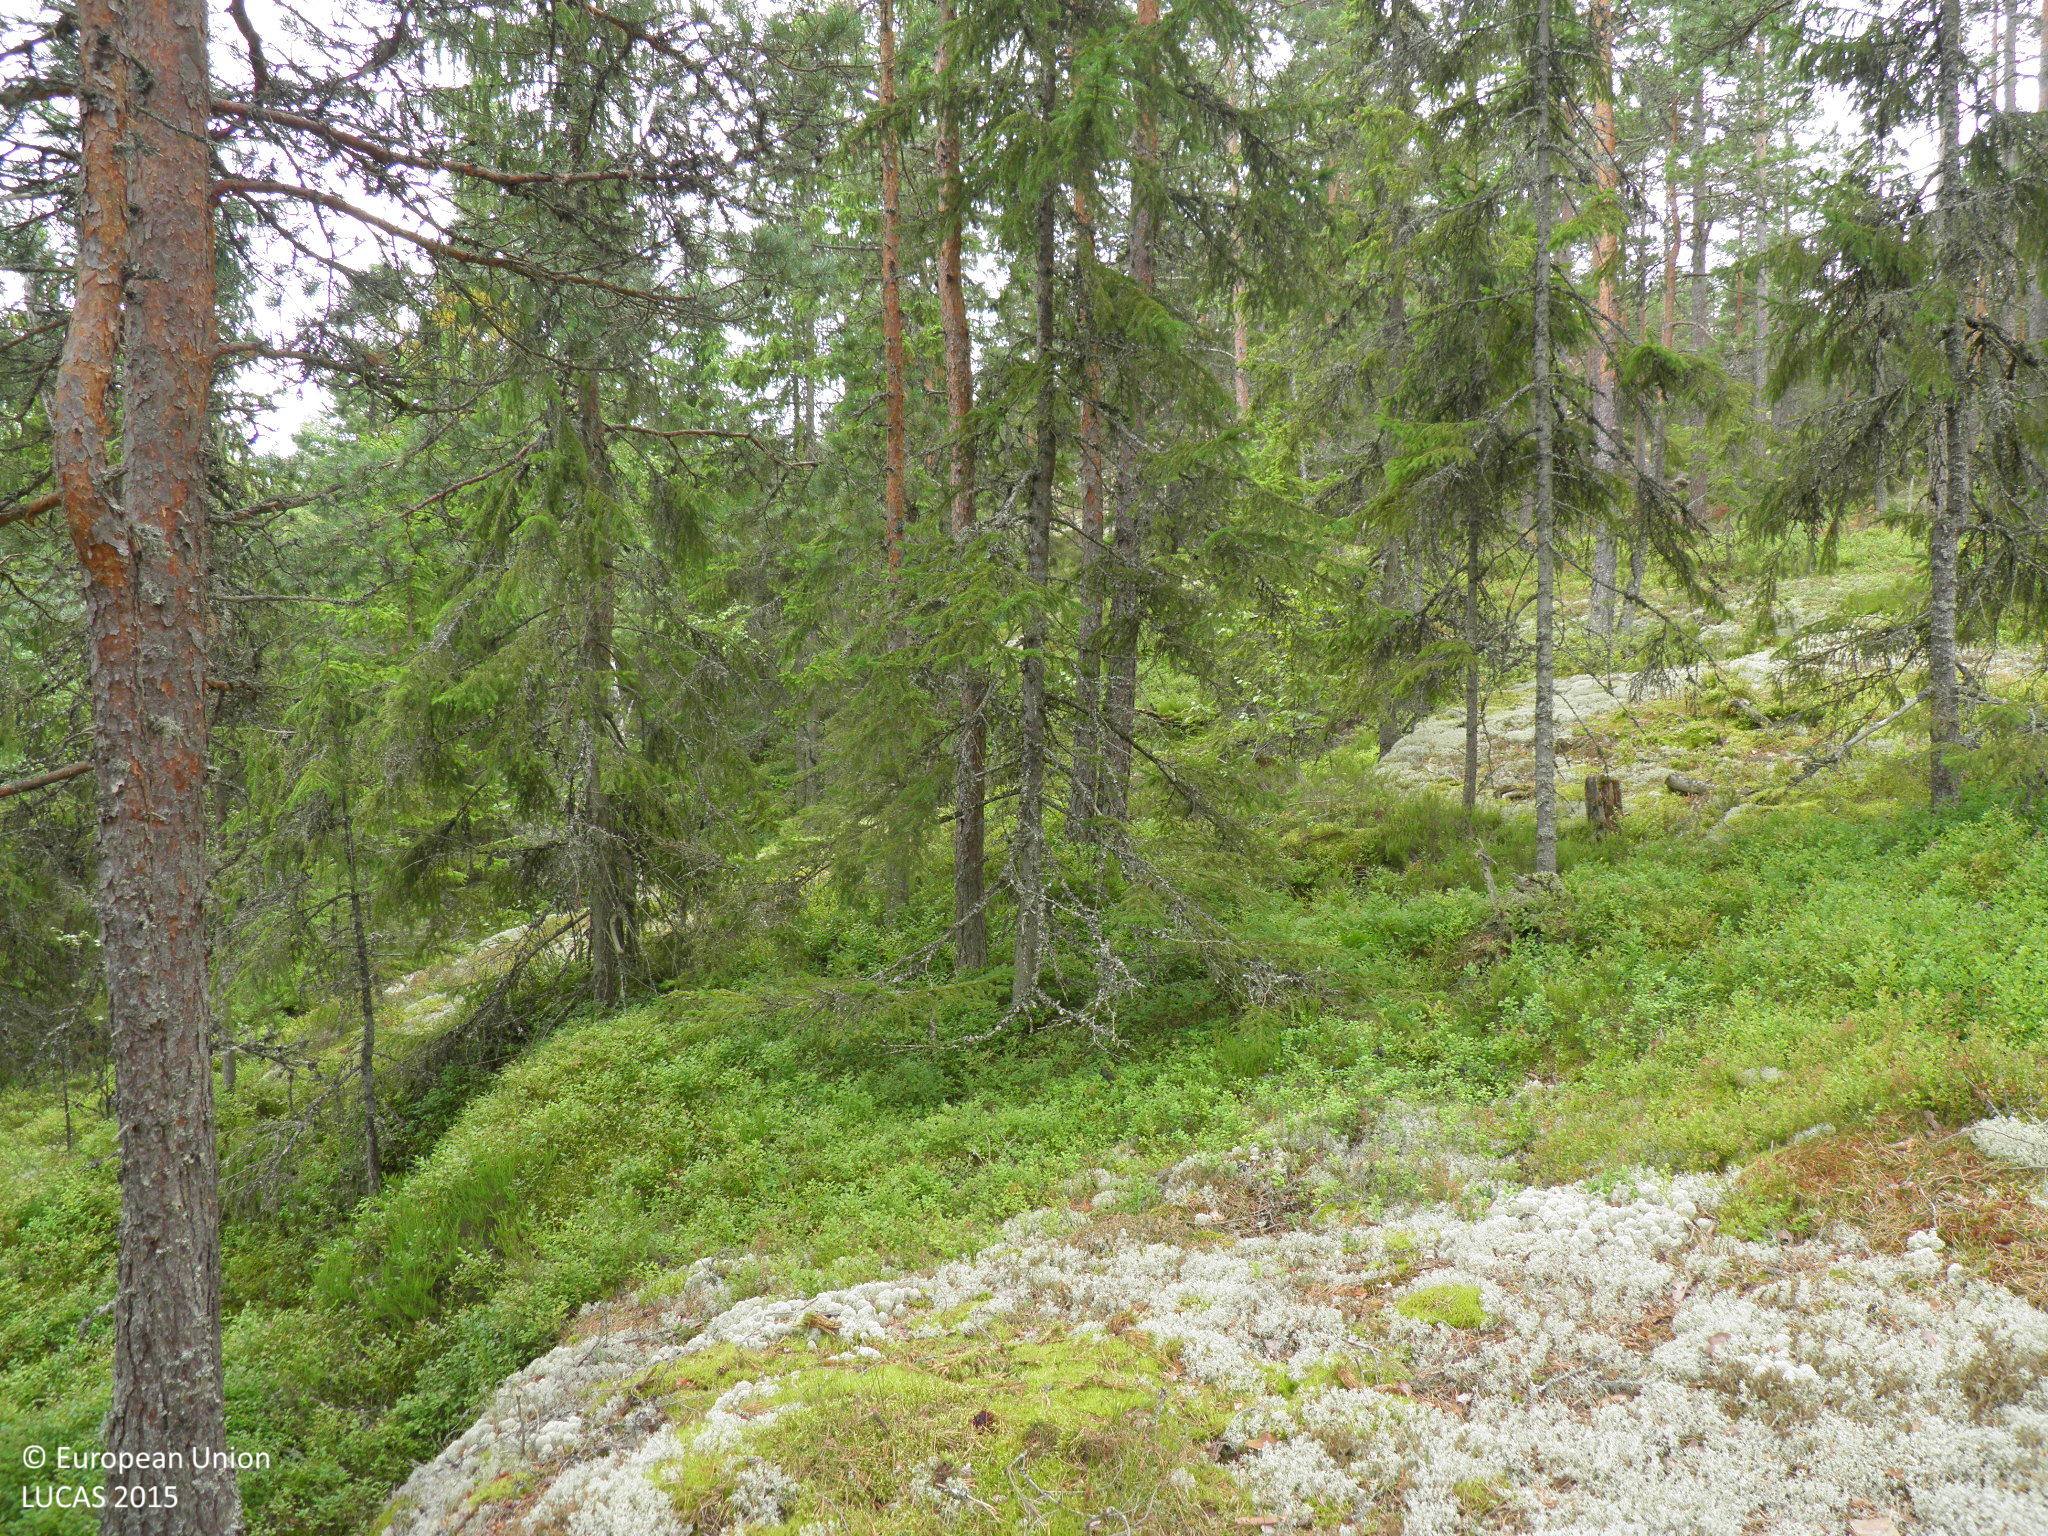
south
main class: Woodland
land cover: Pine dominated coniferous woodland
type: hemiboreal forest and nemoral coniferous forest and mixed broadleaved-coniferous forest
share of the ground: 25 - 50 %
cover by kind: coniferous forest trees 40 %, shrubs 30 %, lichens and mosses 30 %
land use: Forestry
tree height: > 5 m
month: July
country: FI
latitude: 60.2286
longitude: 22.6586
